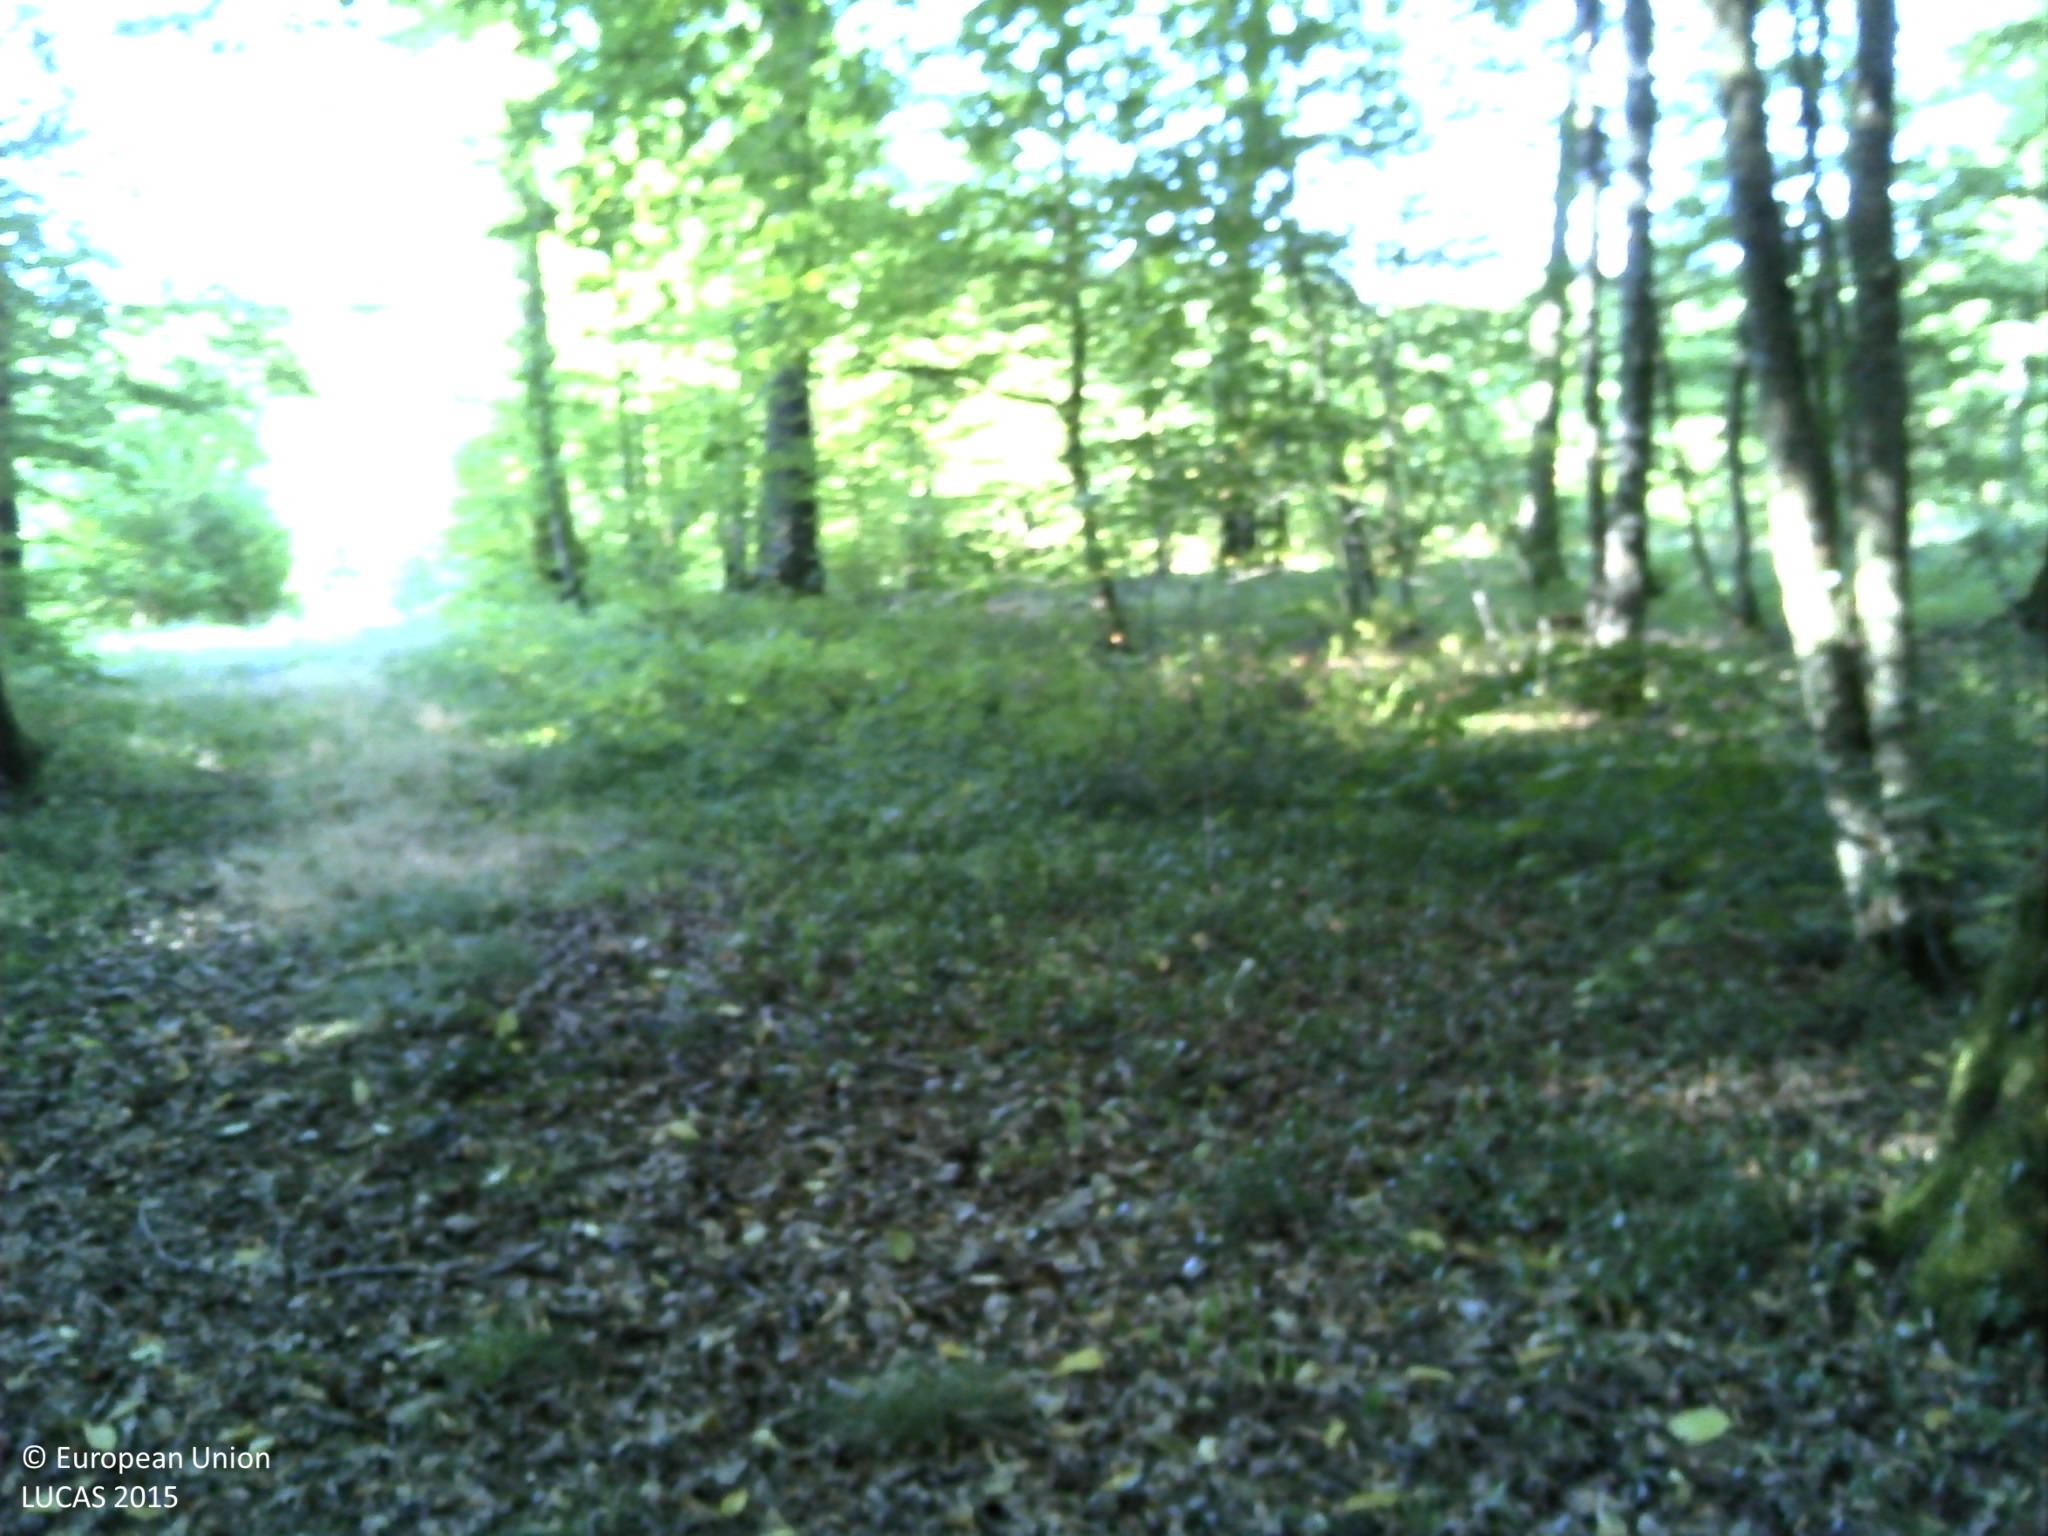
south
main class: Woodland
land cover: Broadleaved woodland
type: mountainous beech forest
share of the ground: > 75 %
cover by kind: broadleaved forest trees 100 %
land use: Forestry
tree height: > 5 m
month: July
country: FR
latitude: 48.2970
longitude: 6.0506
